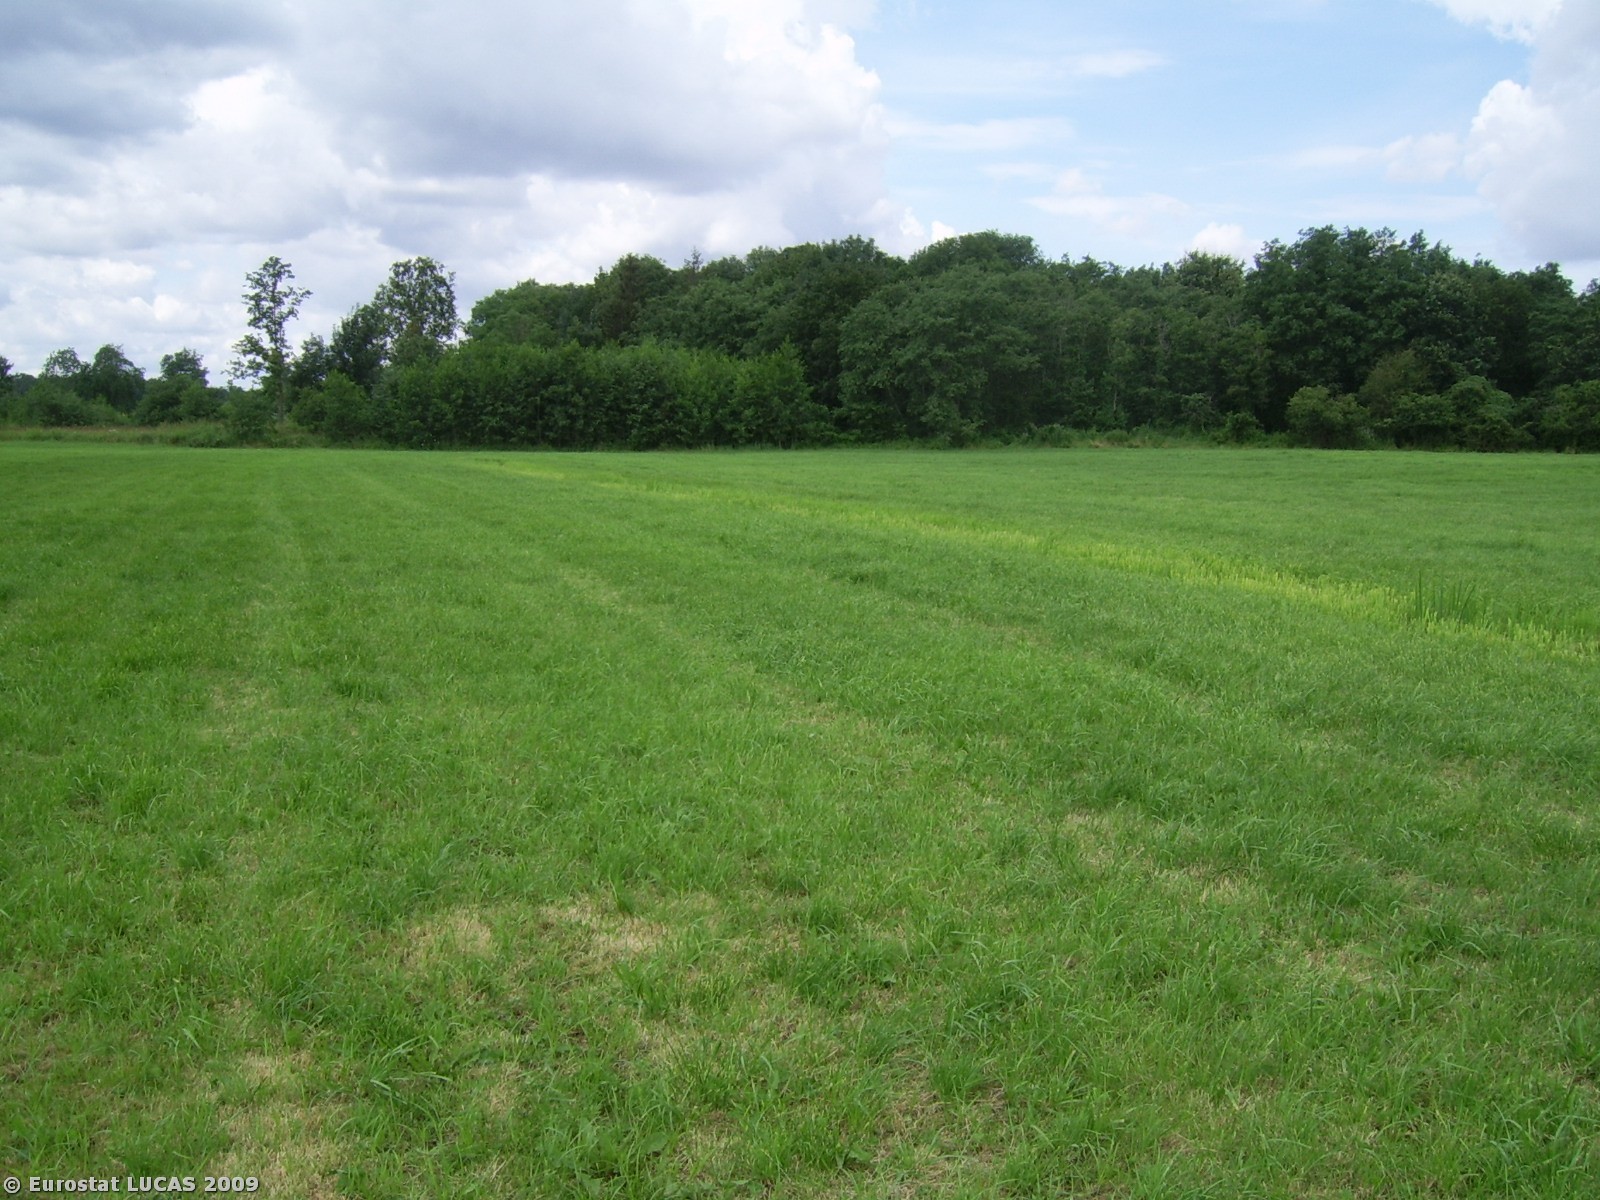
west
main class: Grassland
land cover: Grassland without tree/shrub cover
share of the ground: > 75 %
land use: Agriculture (excluding fallow land and kitchen gardens)
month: July
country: PL
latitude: 51.6728
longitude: 16.8782
